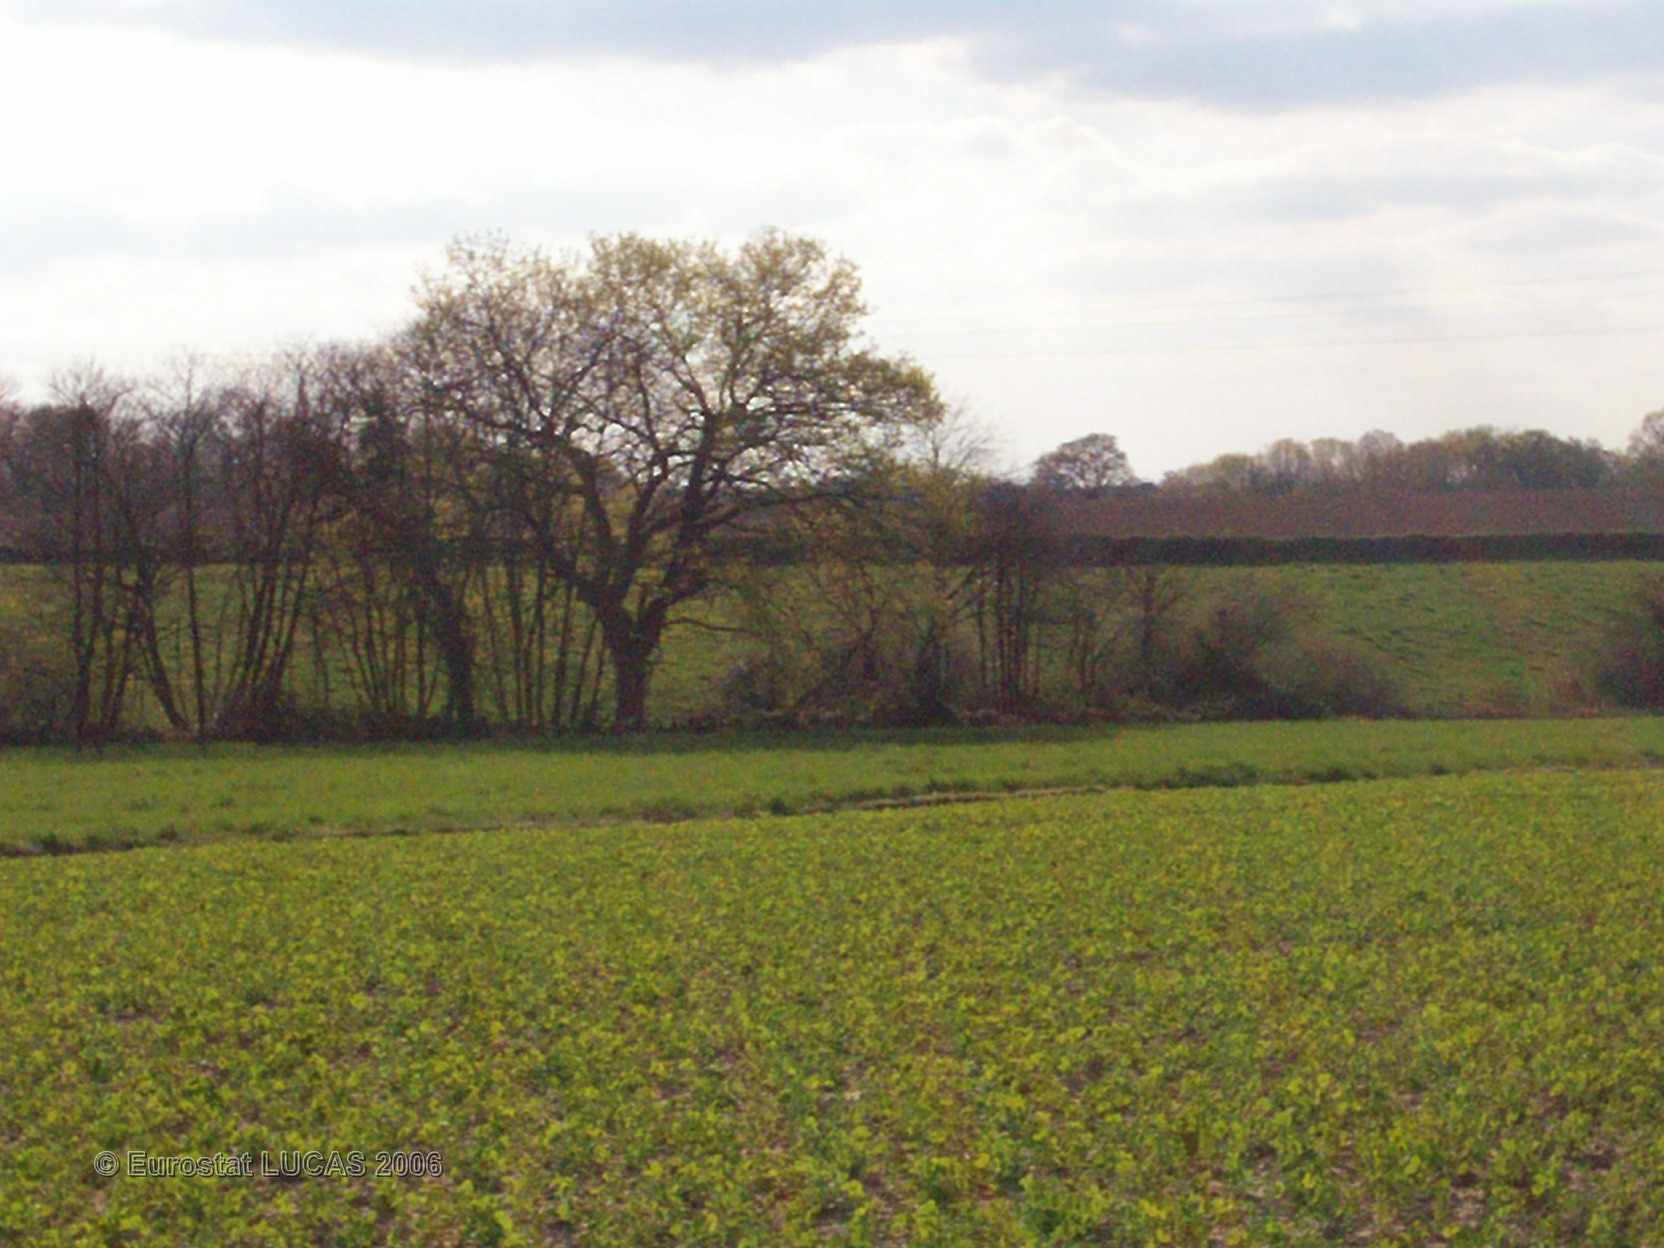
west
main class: Cropland
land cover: Dry pulses
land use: Agriculture (excluding fallow land and kitchen gardens)
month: April
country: FR
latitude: 43.4167
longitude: -0.3199
